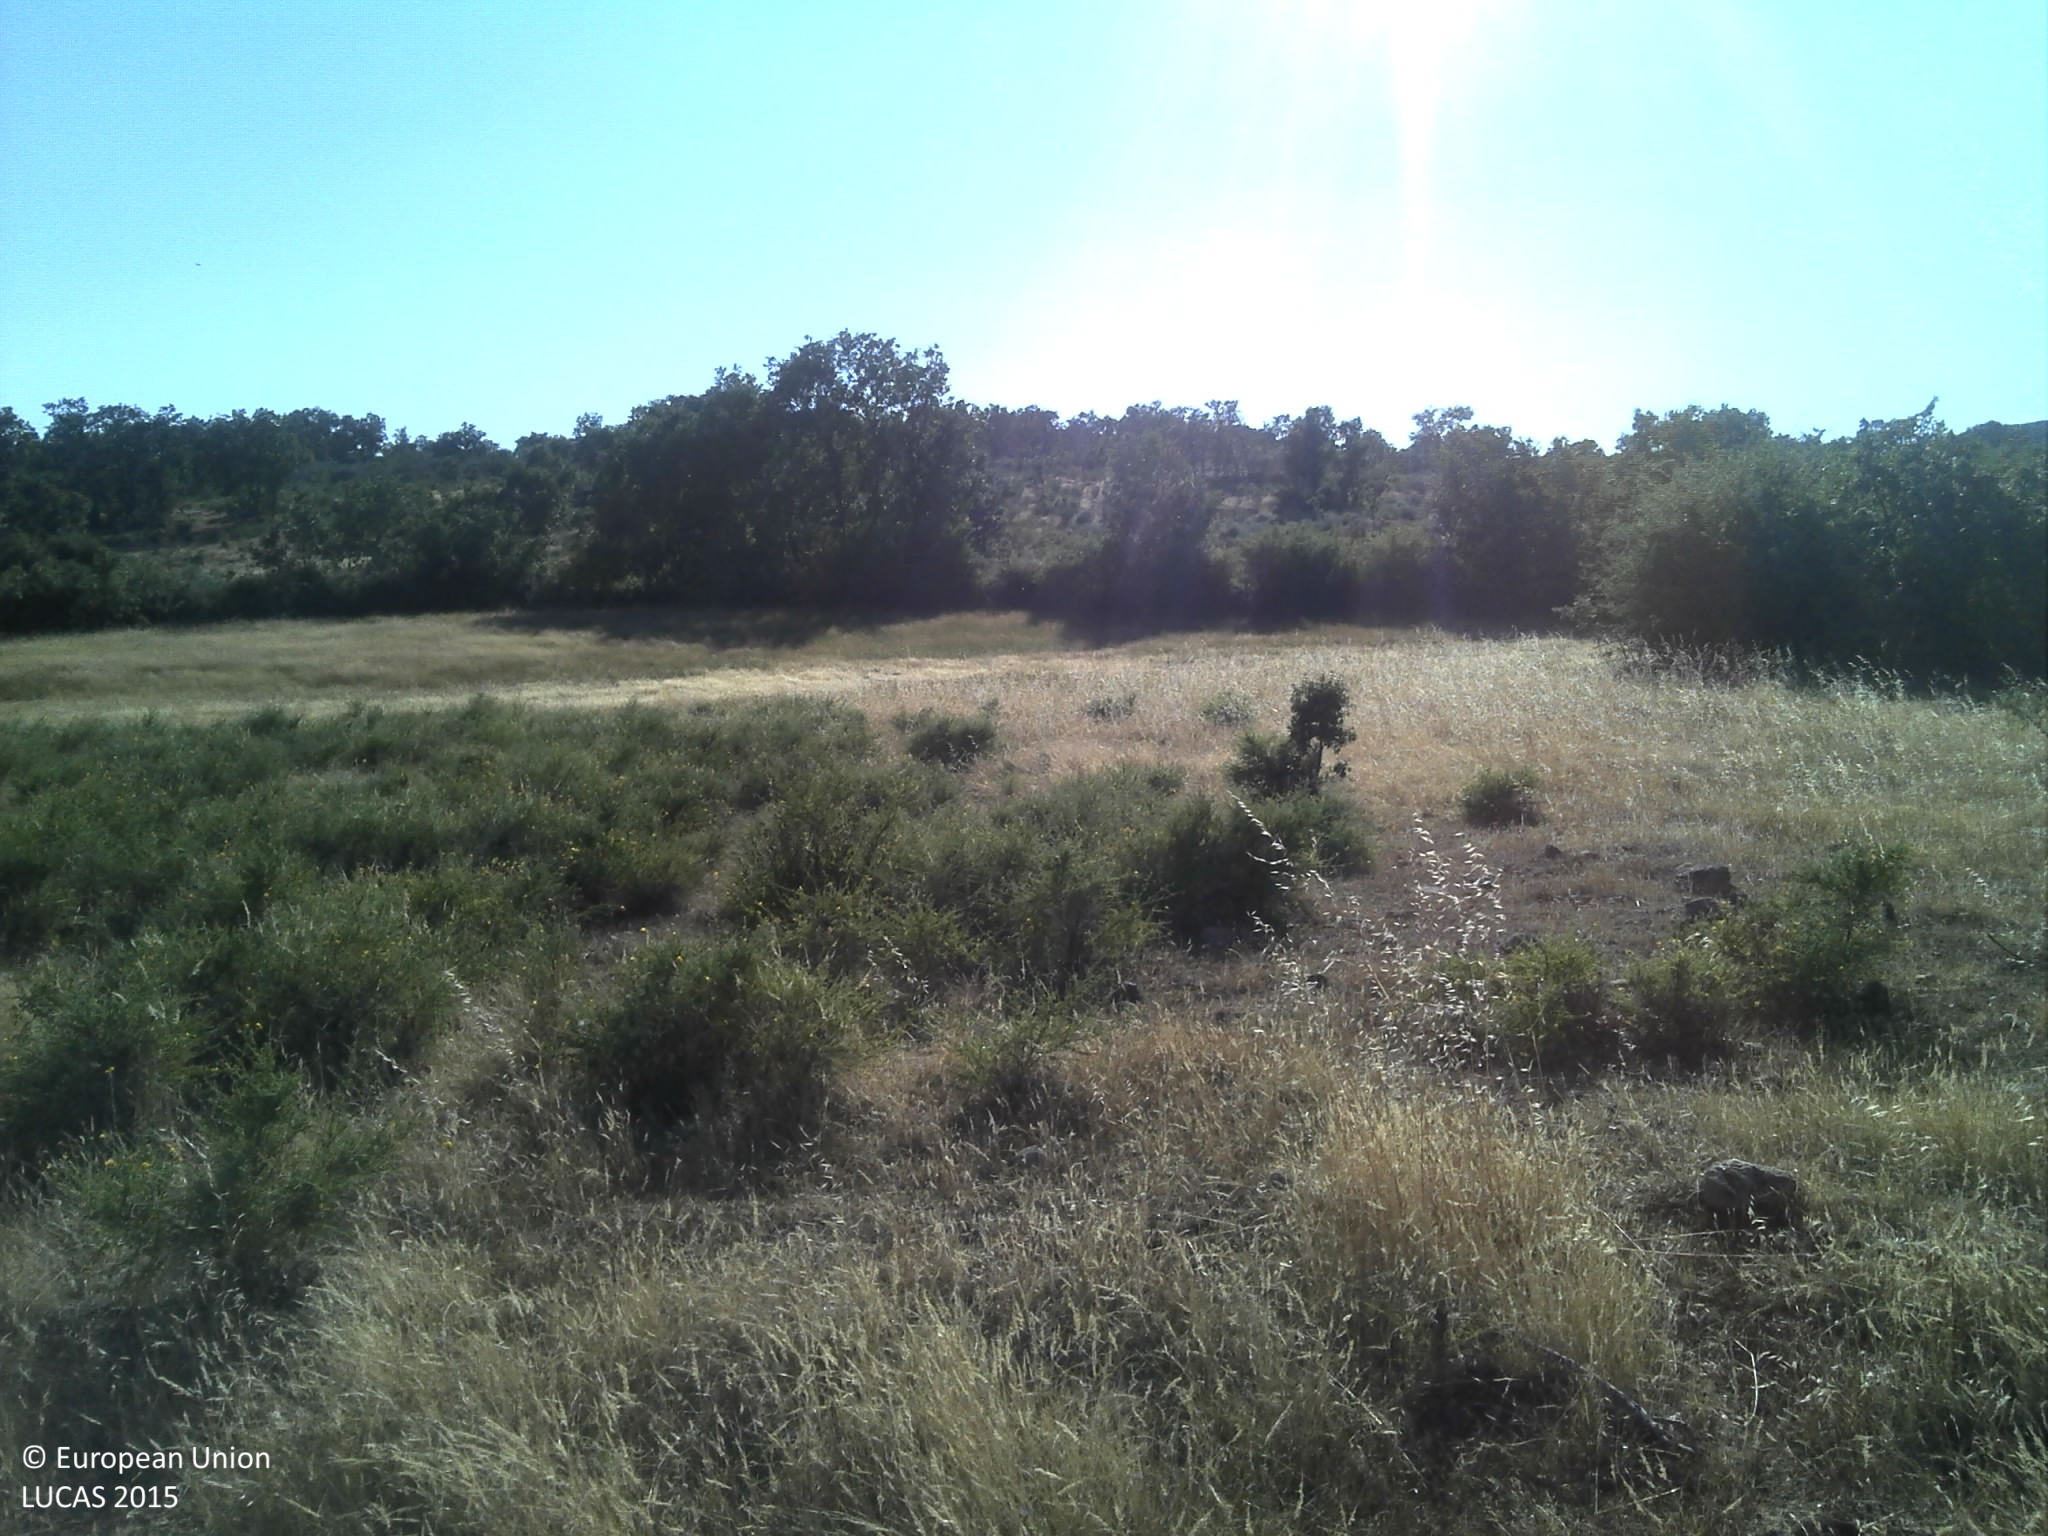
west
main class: Grassland
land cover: Grassland with sparse tree/shrub cover
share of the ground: 25 - 50 %
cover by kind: herbaceous plants 45 %, unconsolidated bare surface 40 %, broadleaved forest trees 5 %, shrubs 5 %
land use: Agriculture (excluding fallow land and kitchen gardens)
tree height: > 5 m
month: June
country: PT
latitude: 39.9766
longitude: -7.2740
